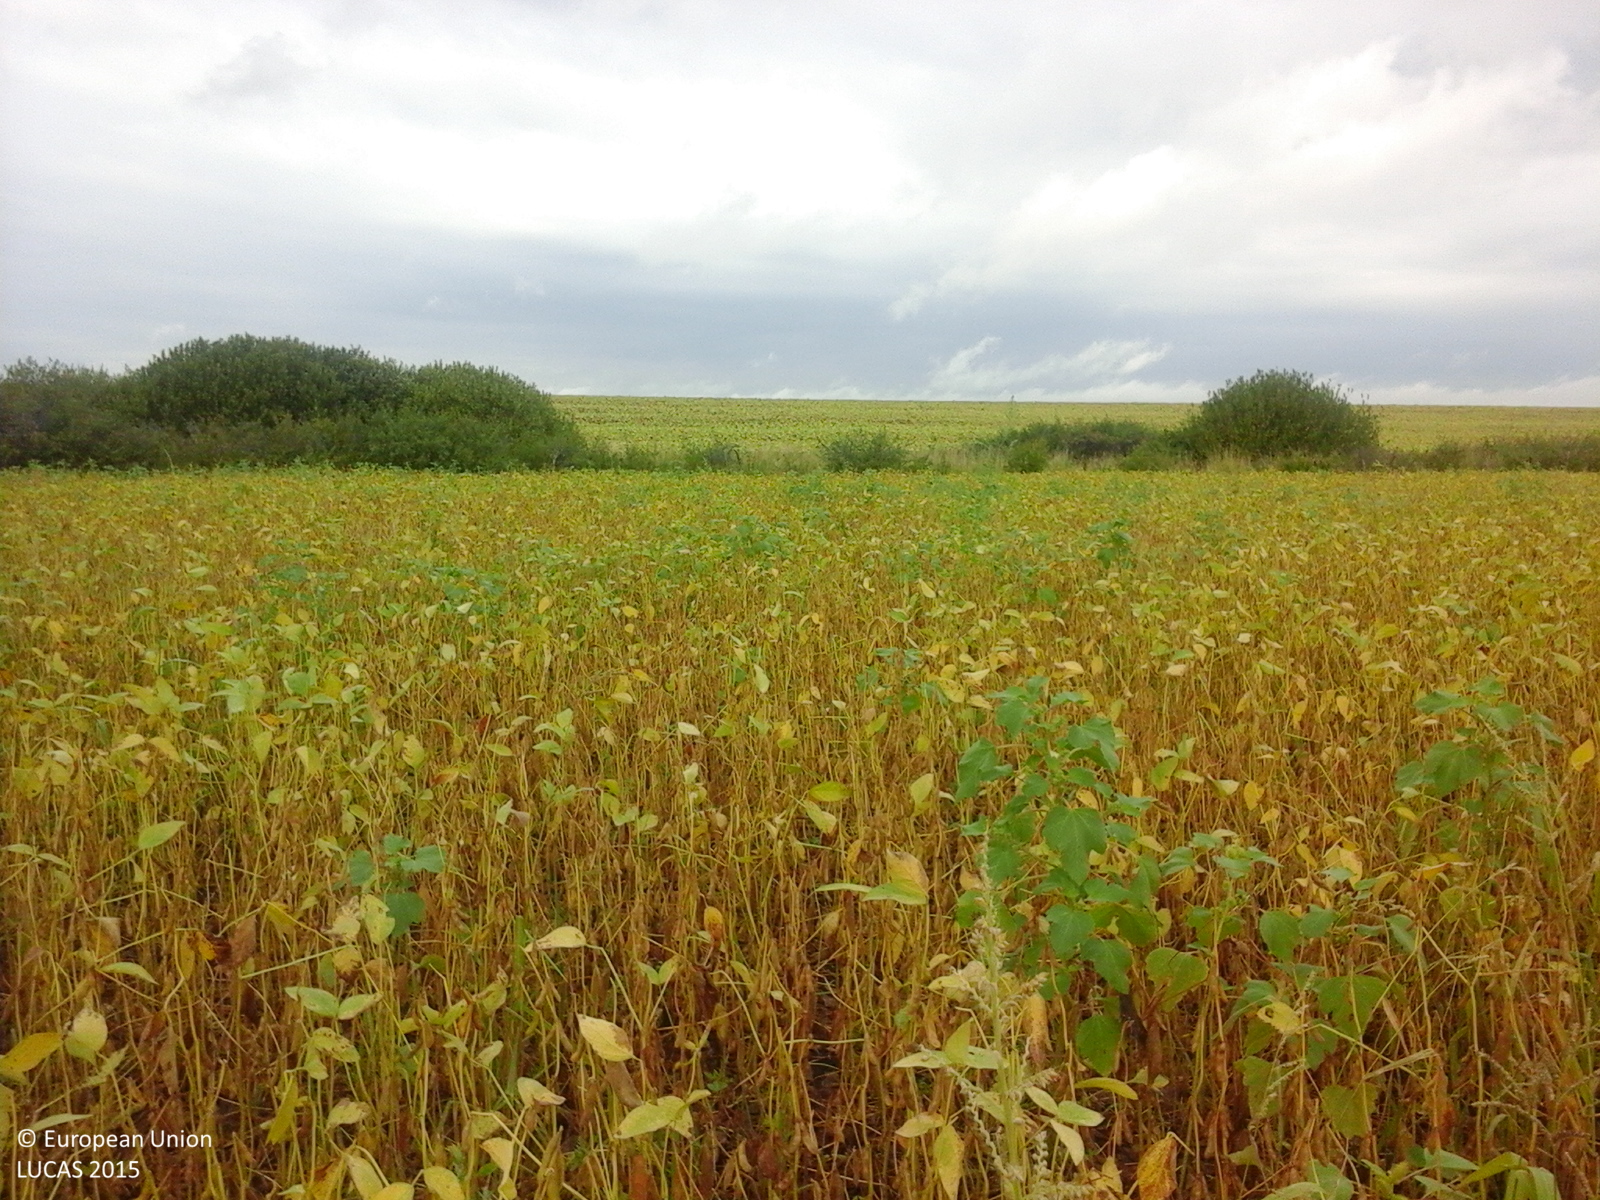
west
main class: Cropland
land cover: Soya
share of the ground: > 75 %
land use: Agriculture (excluding fallow land and kitchen gardens)
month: August
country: RO
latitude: 45.5978
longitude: 21.5327
